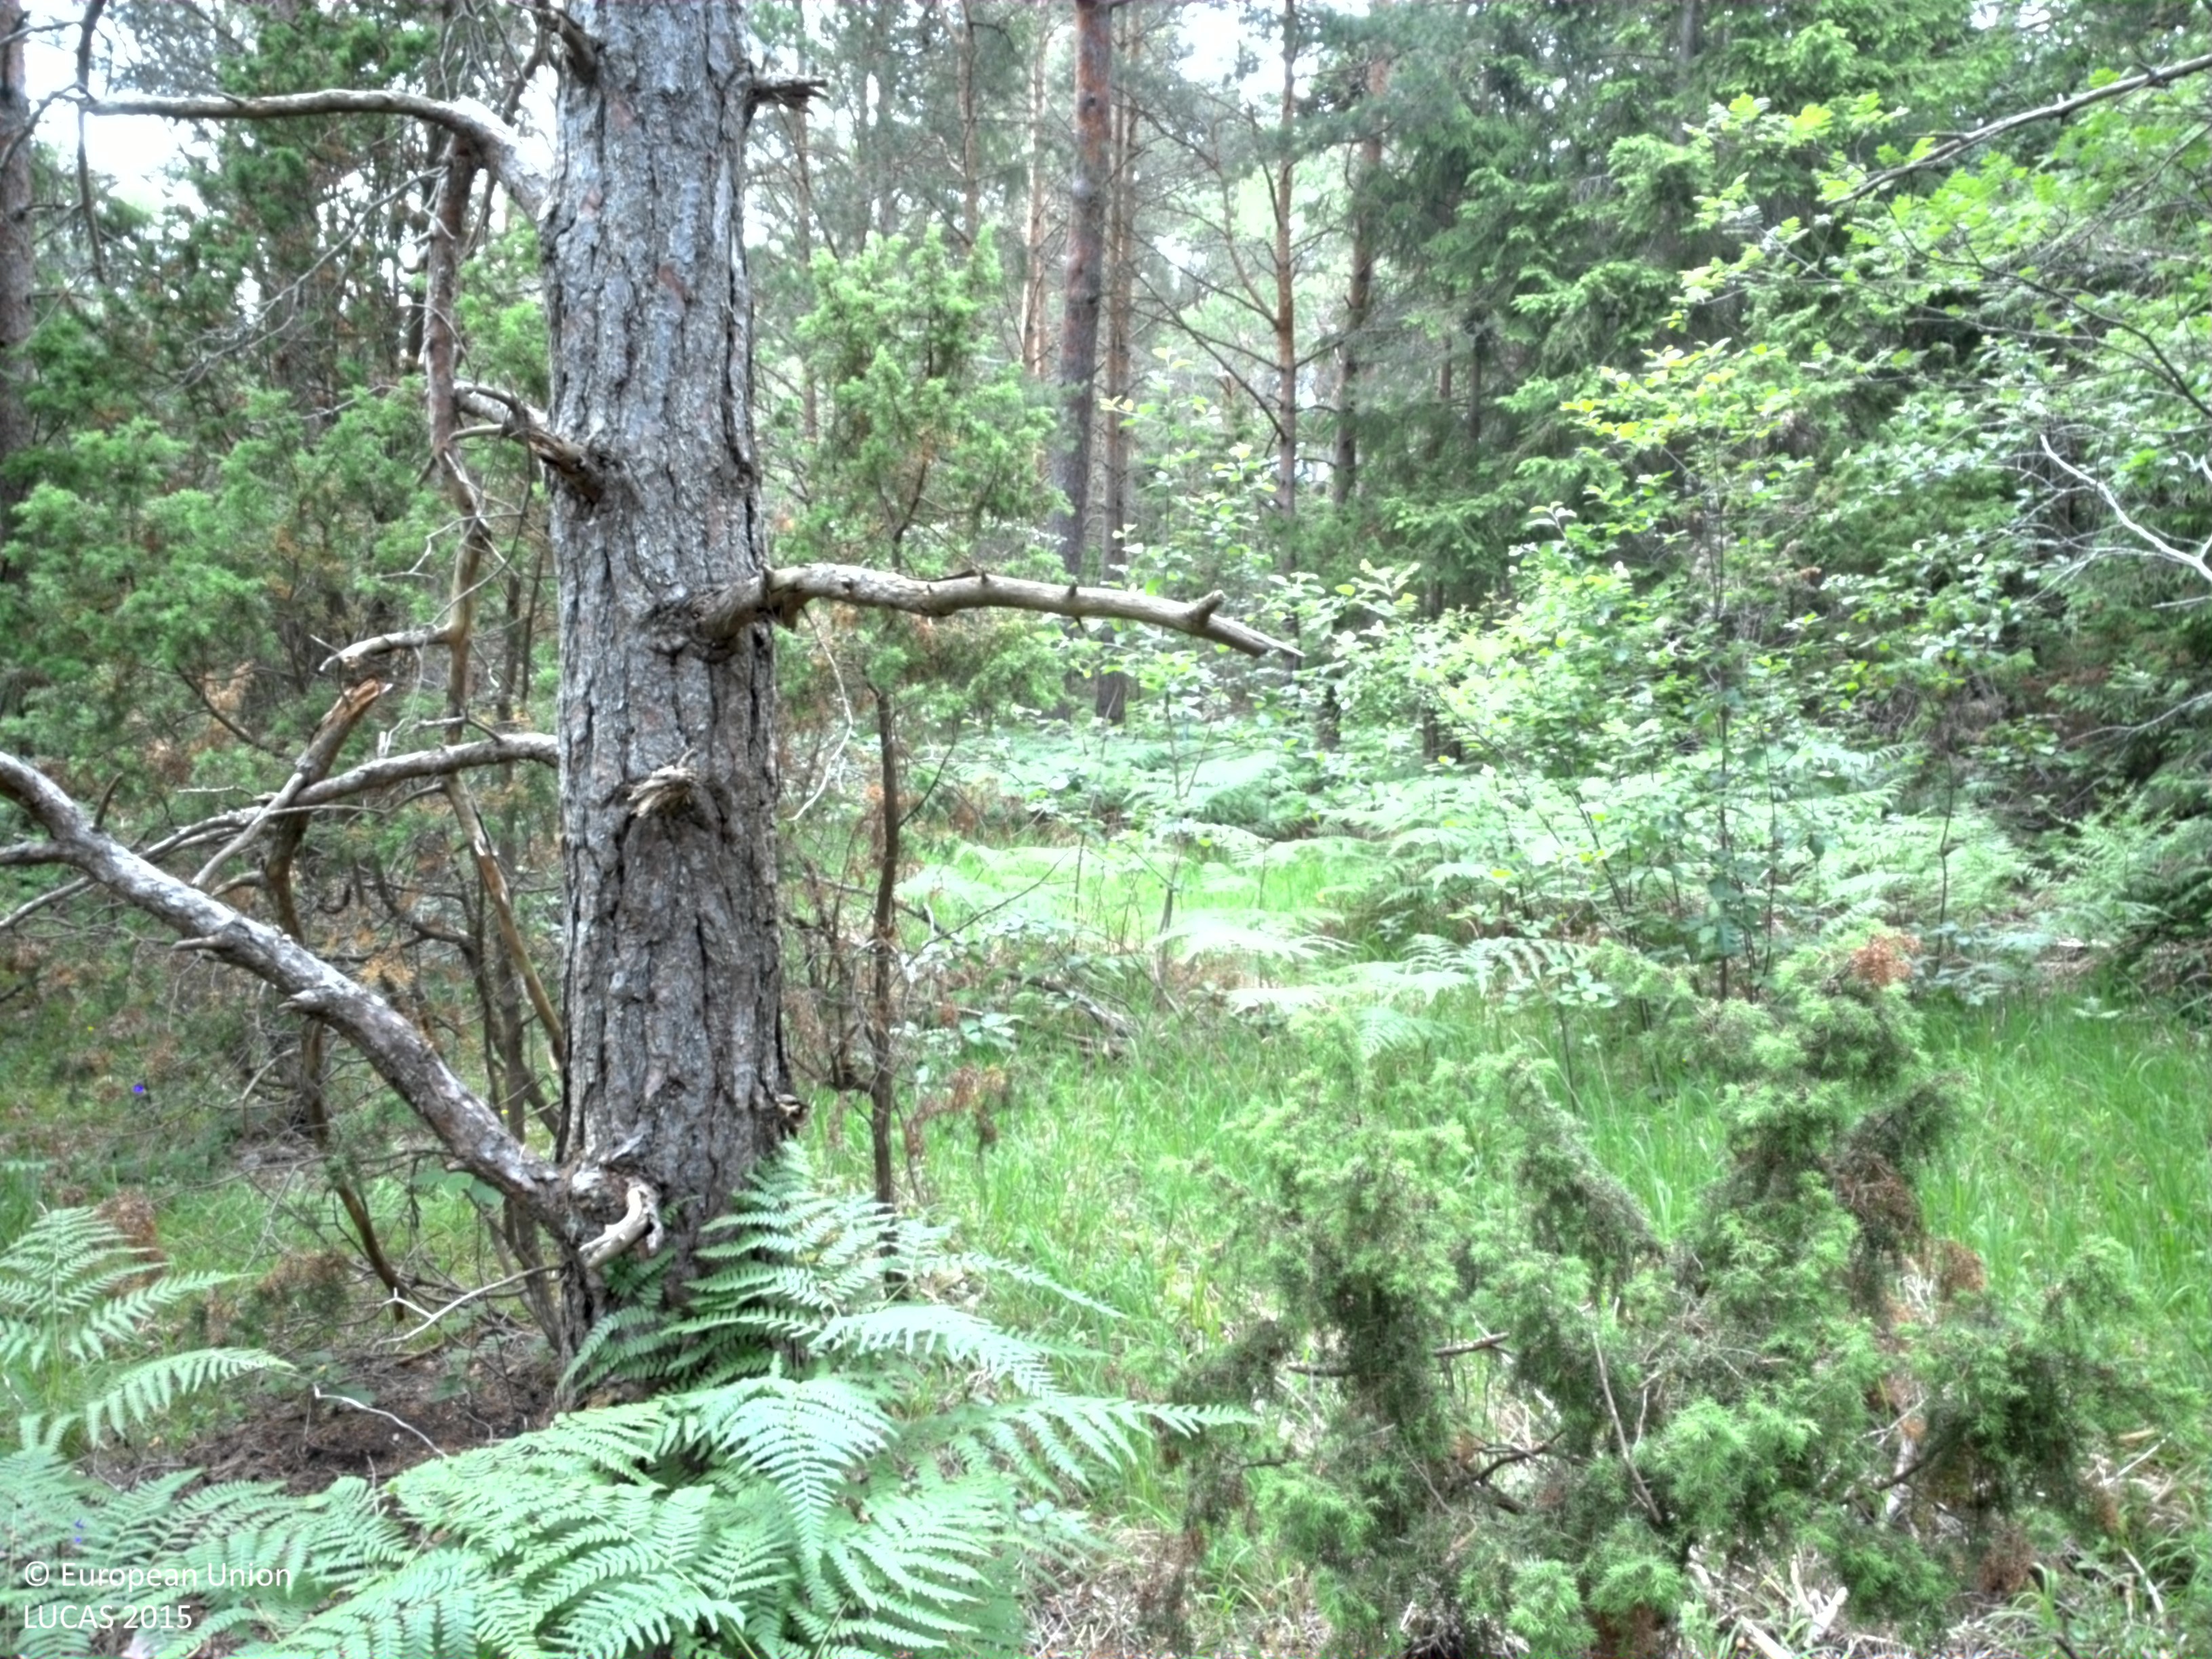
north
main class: Woodland
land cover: Pine dominated coniferous woodland
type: hemiboreal forest and nemoral coniferous forest and mixed broadleaved-coniferous forest
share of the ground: > 75 %
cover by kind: coniferous forest trees 70 %, herbaceous plants 15 %, shrubs 10 %, broadleaved forest trees 5 %
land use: Forestry
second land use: Amenities, museums, leisure
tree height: > 5 m
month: June
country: SE
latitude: 57.8744
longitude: 18.8274
